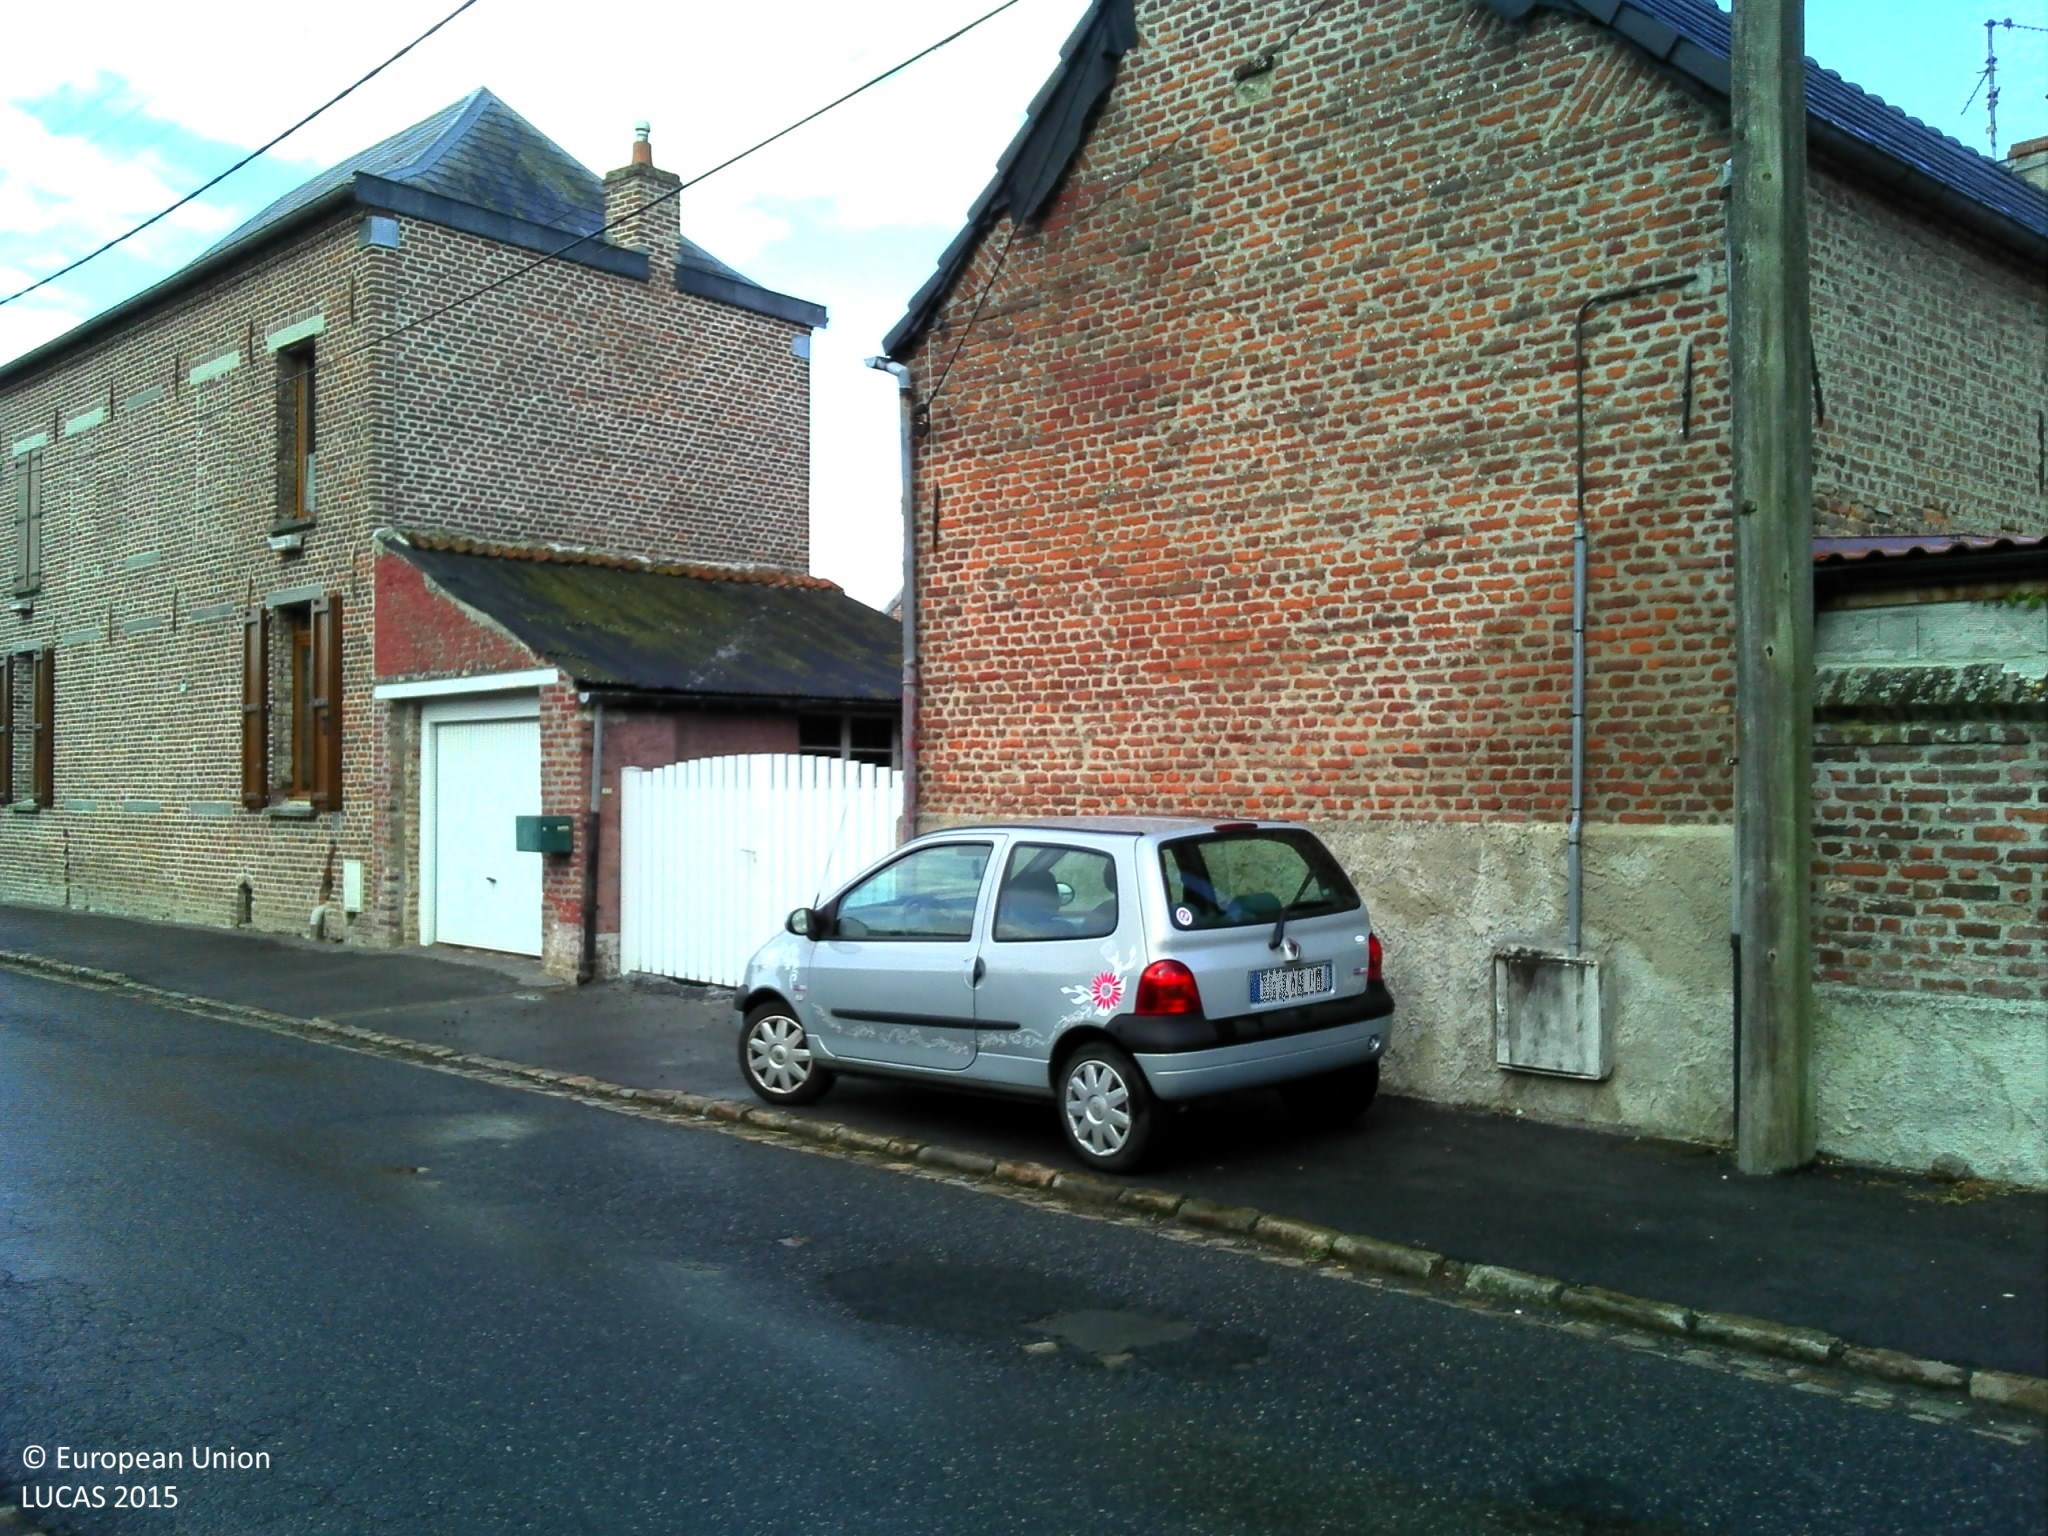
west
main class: Woodland
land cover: Broadleaved woodland
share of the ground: > 75 %
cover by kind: broadleaved forest trees 85 %, herbaceous plants 15 %
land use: Residential
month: July
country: FR
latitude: 50.3292
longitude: 3.6011
